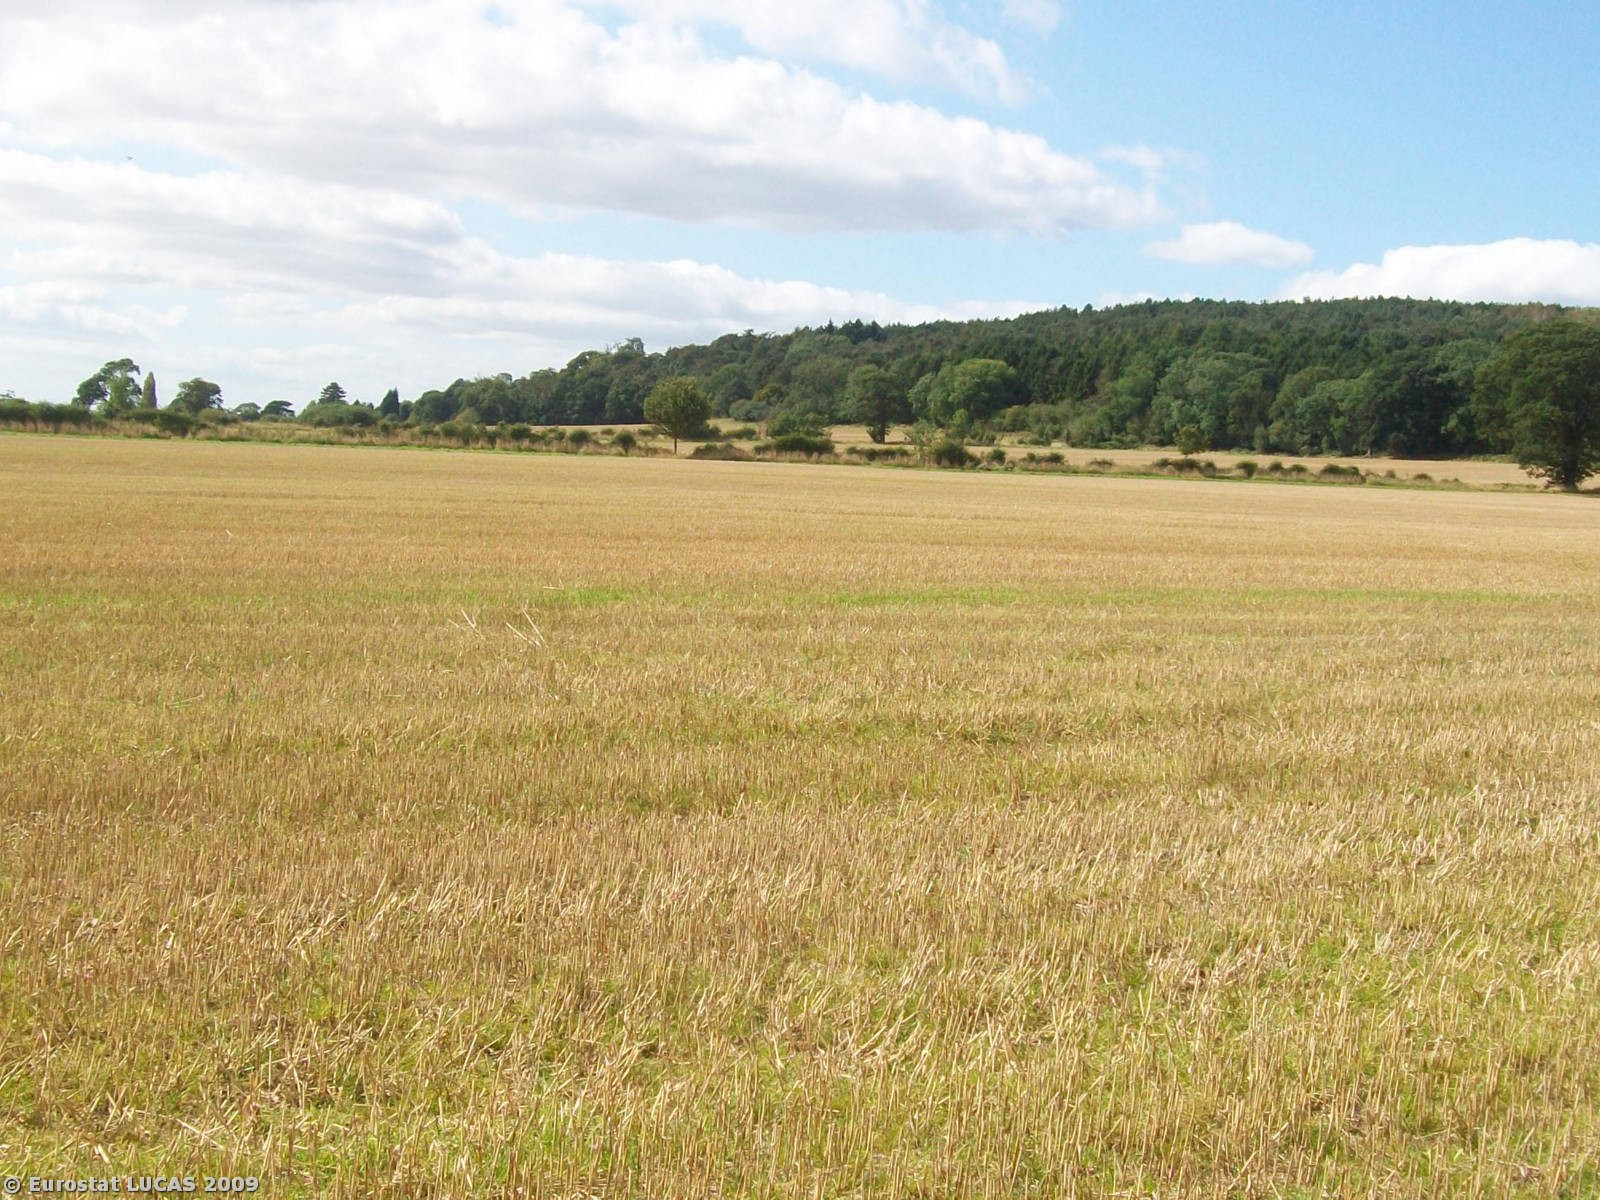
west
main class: Cropland
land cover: Common wheat
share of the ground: < 10 %
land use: Agriculture (excluding fallow land and kitchen gardens)
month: September
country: GB
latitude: 52.7152
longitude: -2.6666
